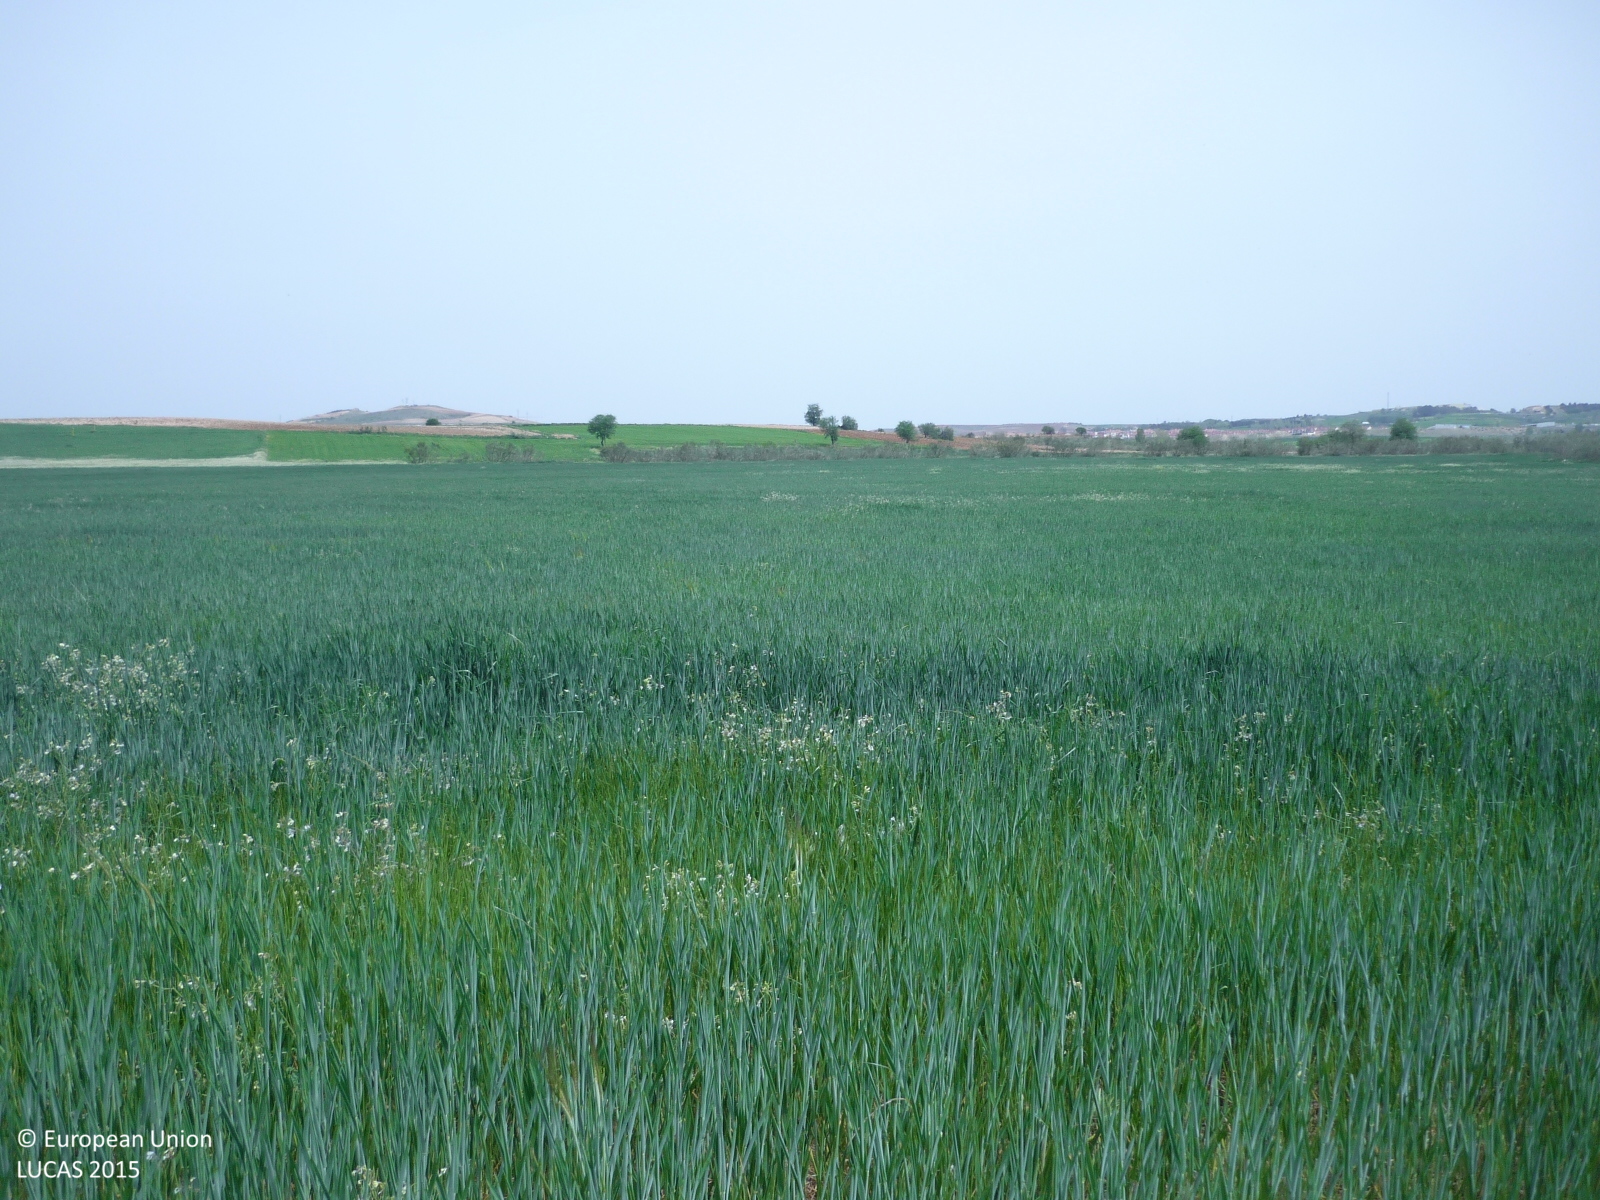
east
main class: Cropland
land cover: Rye
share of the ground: > 75 %
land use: Agriculture (excluding fallow land and kitchen gardens)
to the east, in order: Rye; Grass margins; Common wheat; Shrubland without tree cover; Tracks; Shrubland without tree cover; Common wheat
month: April
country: ES
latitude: 40.5694
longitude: -3.5384
